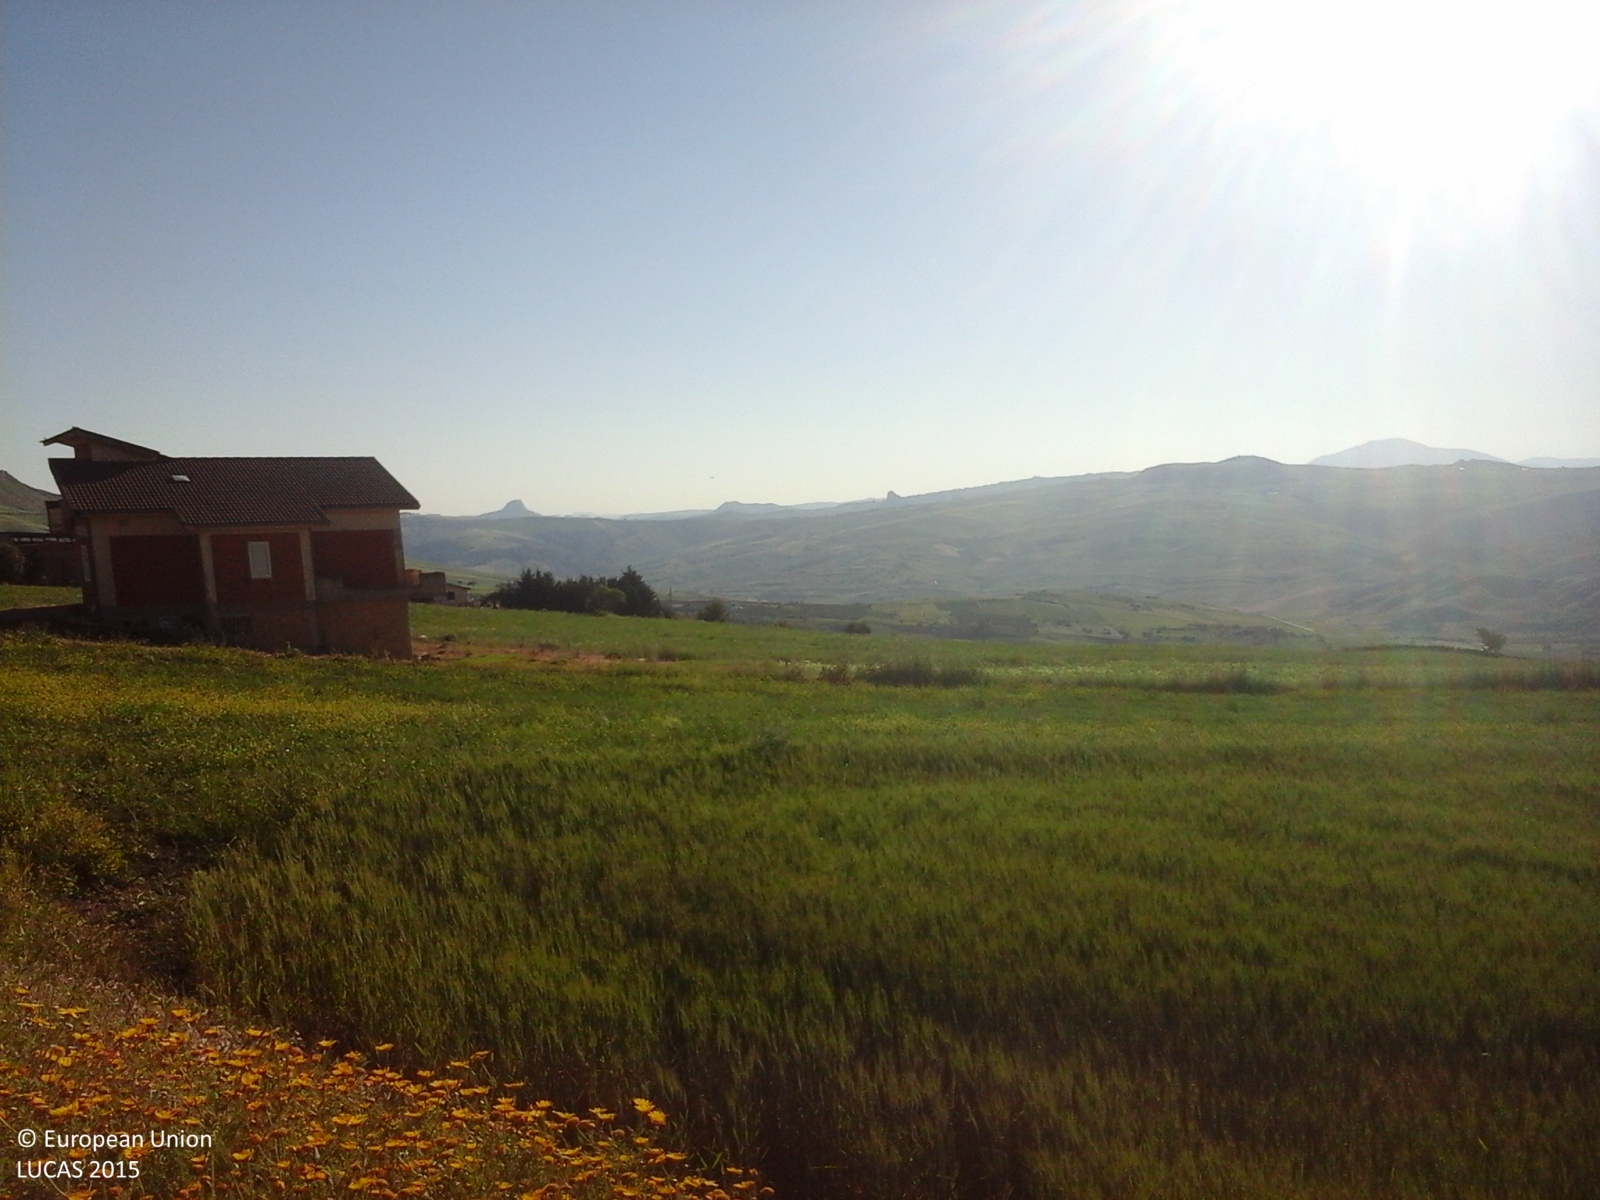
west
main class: Cropland
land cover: Durum wheat
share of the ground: > 75 %
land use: Agriculture (excluding fallow land and kitchen gardens)
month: May
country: IT
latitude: 37.6120
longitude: 13.9246
